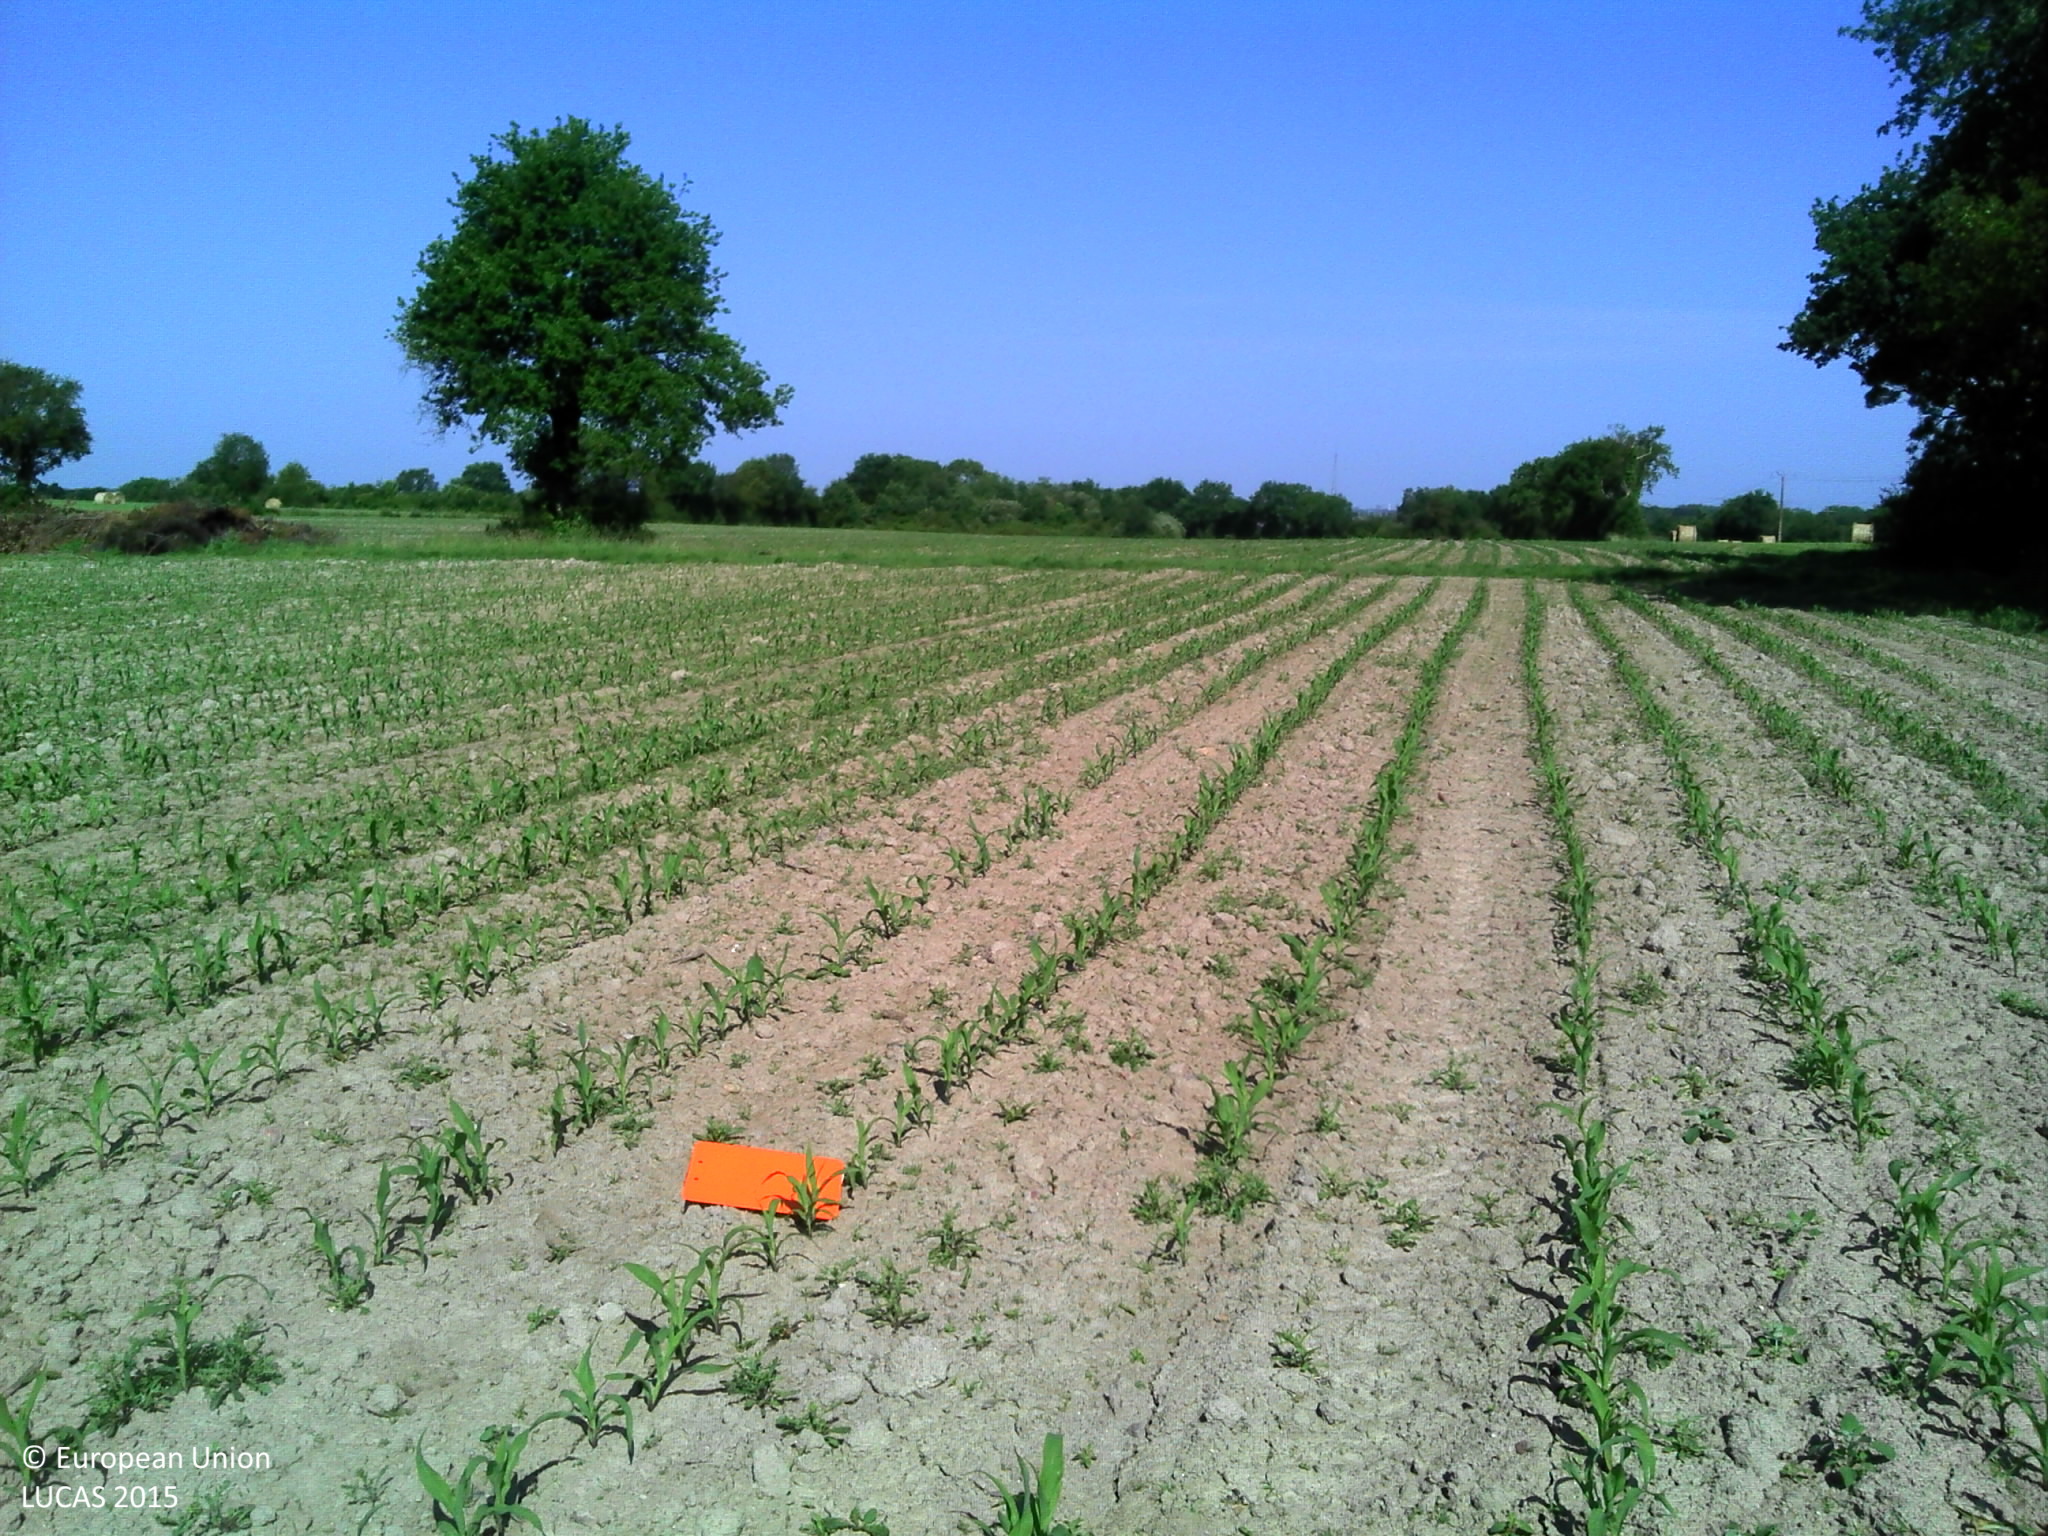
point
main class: Cropland
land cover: Maize
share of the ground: 10 - 25 %
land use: Agriculture (excluding fallow land and kitchen gardens)
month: June
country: FR
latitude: 47.0678
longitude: -1.2166
